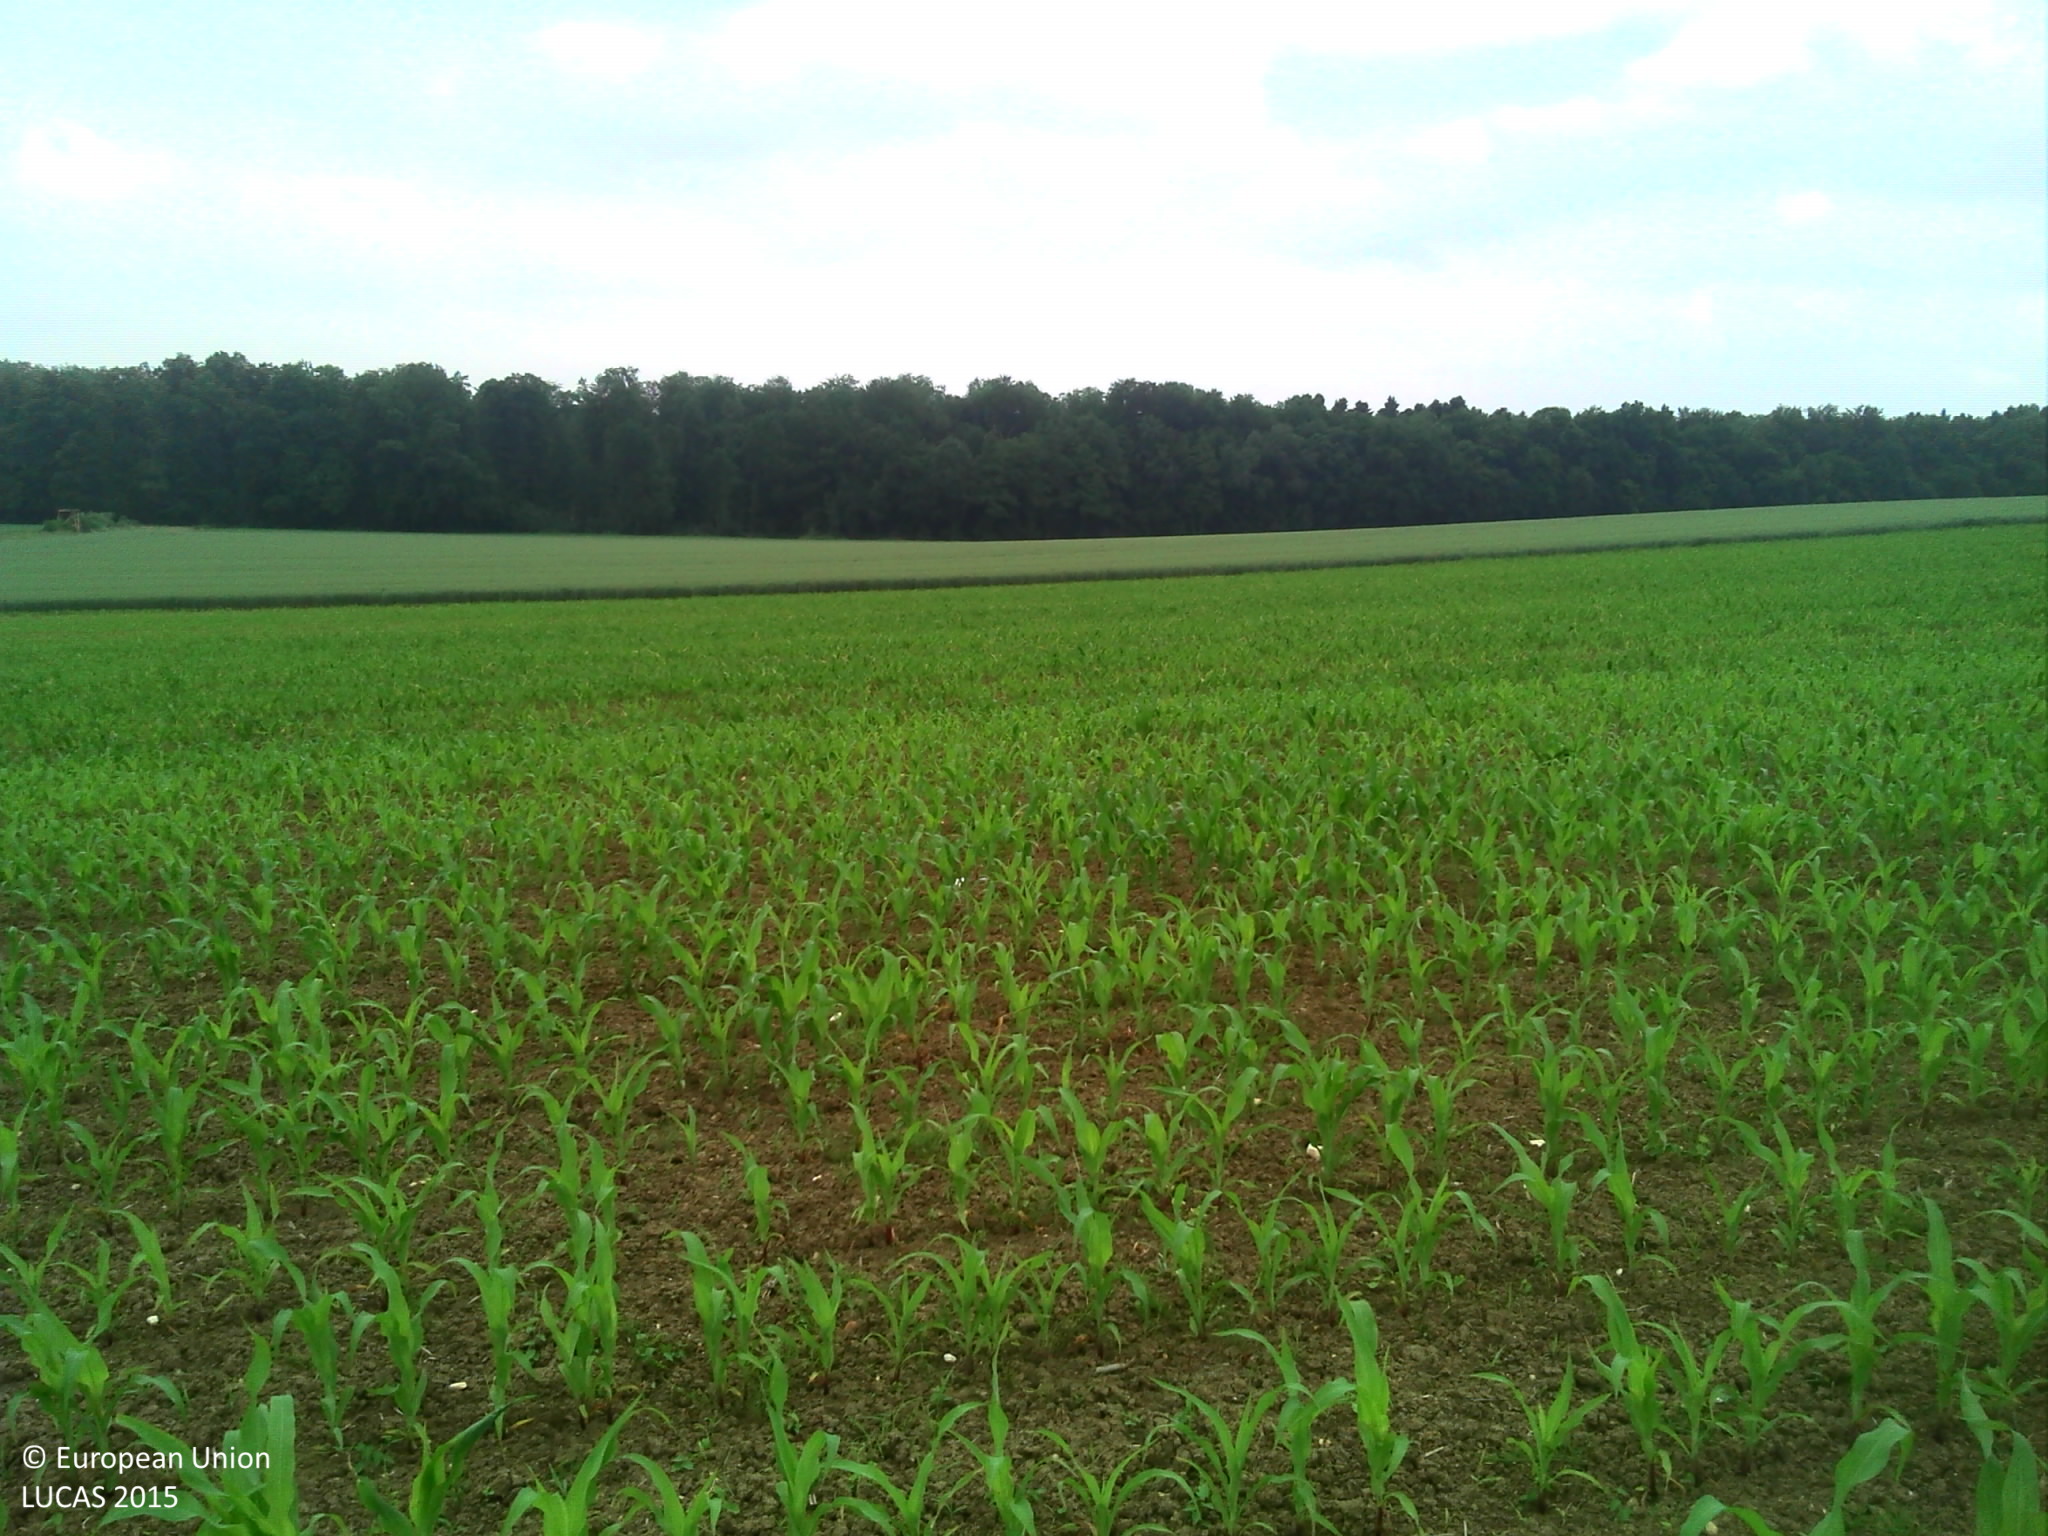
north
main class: Cropland
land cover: Maize
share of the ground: 10 - 25 %
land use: Agriculture (excluding fallow land and kitchen gardens)
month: June
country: FR
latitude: 47.4730
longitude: 7.4144
